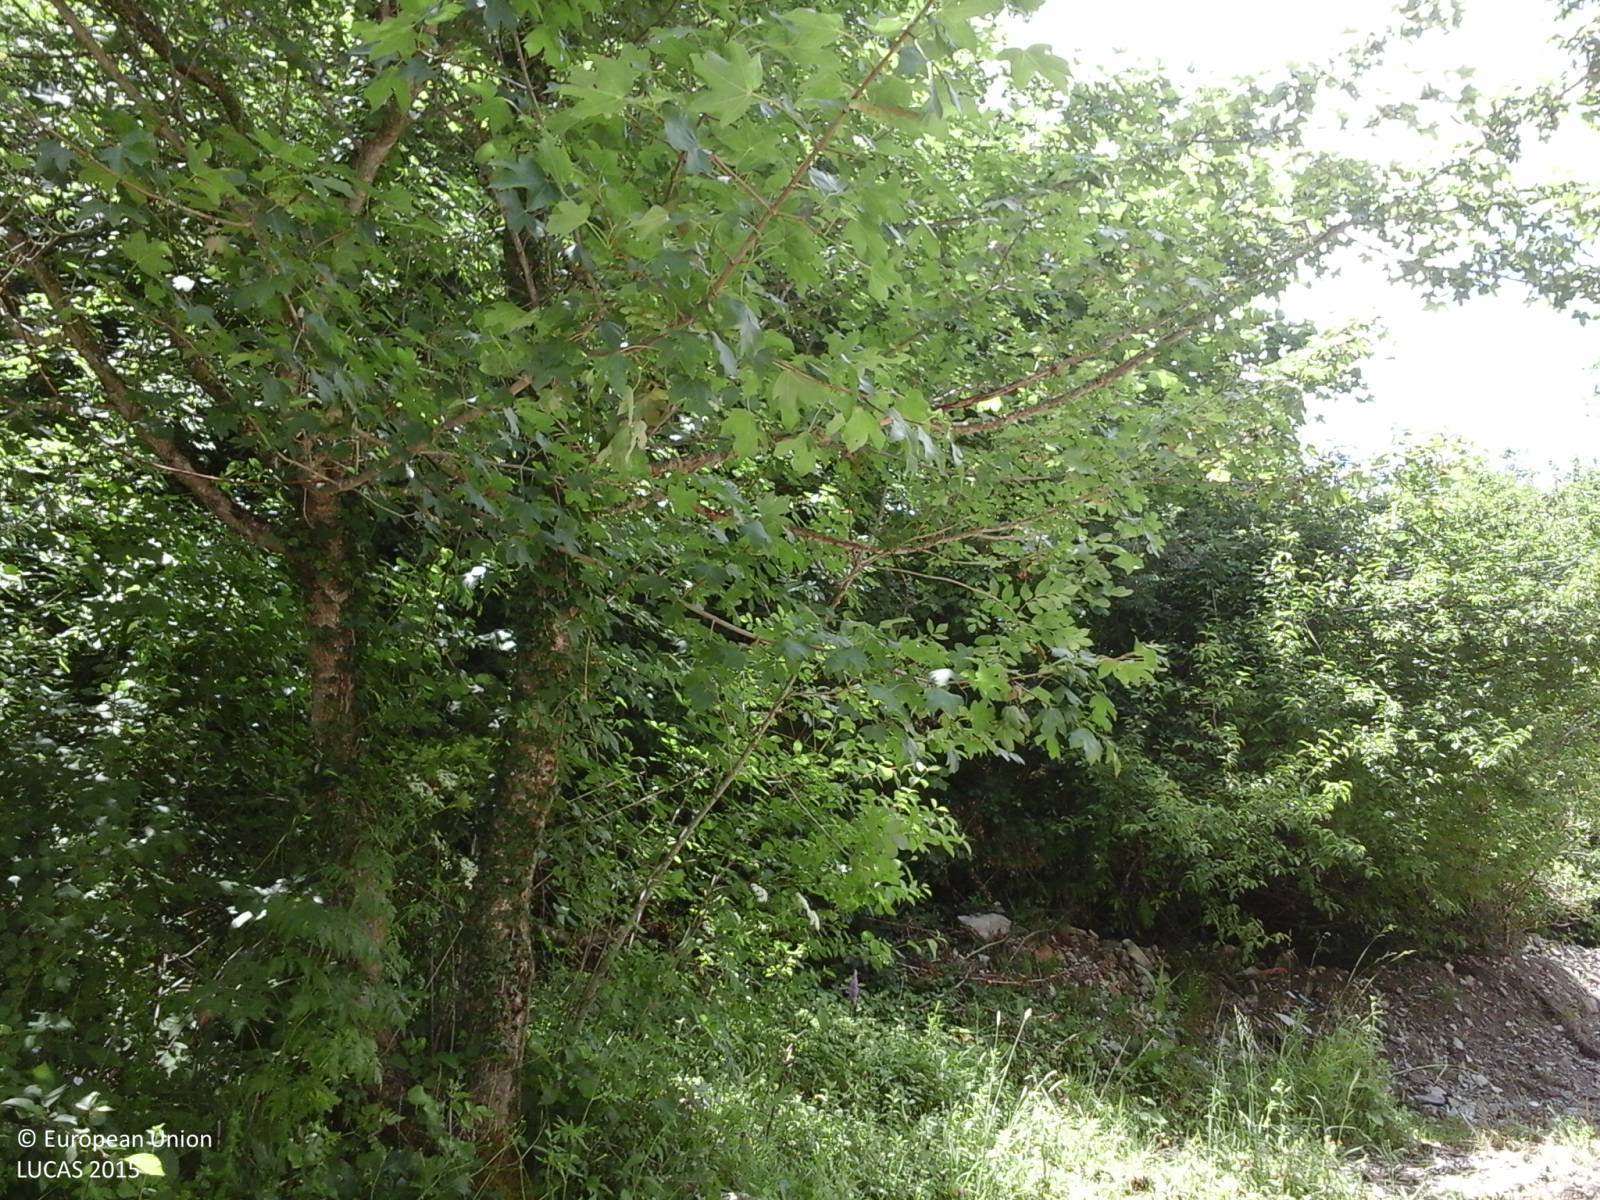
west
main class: Woodland
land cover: Broadleaved woodland
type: thermophilous deciduous forest
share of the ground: > 75 %
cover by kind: broadleaved forest trees 100 %
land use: Semi-natural and natural areas not in use
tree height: < 5 m
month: June
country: IT
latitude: 41.4418
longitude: 14.2810
